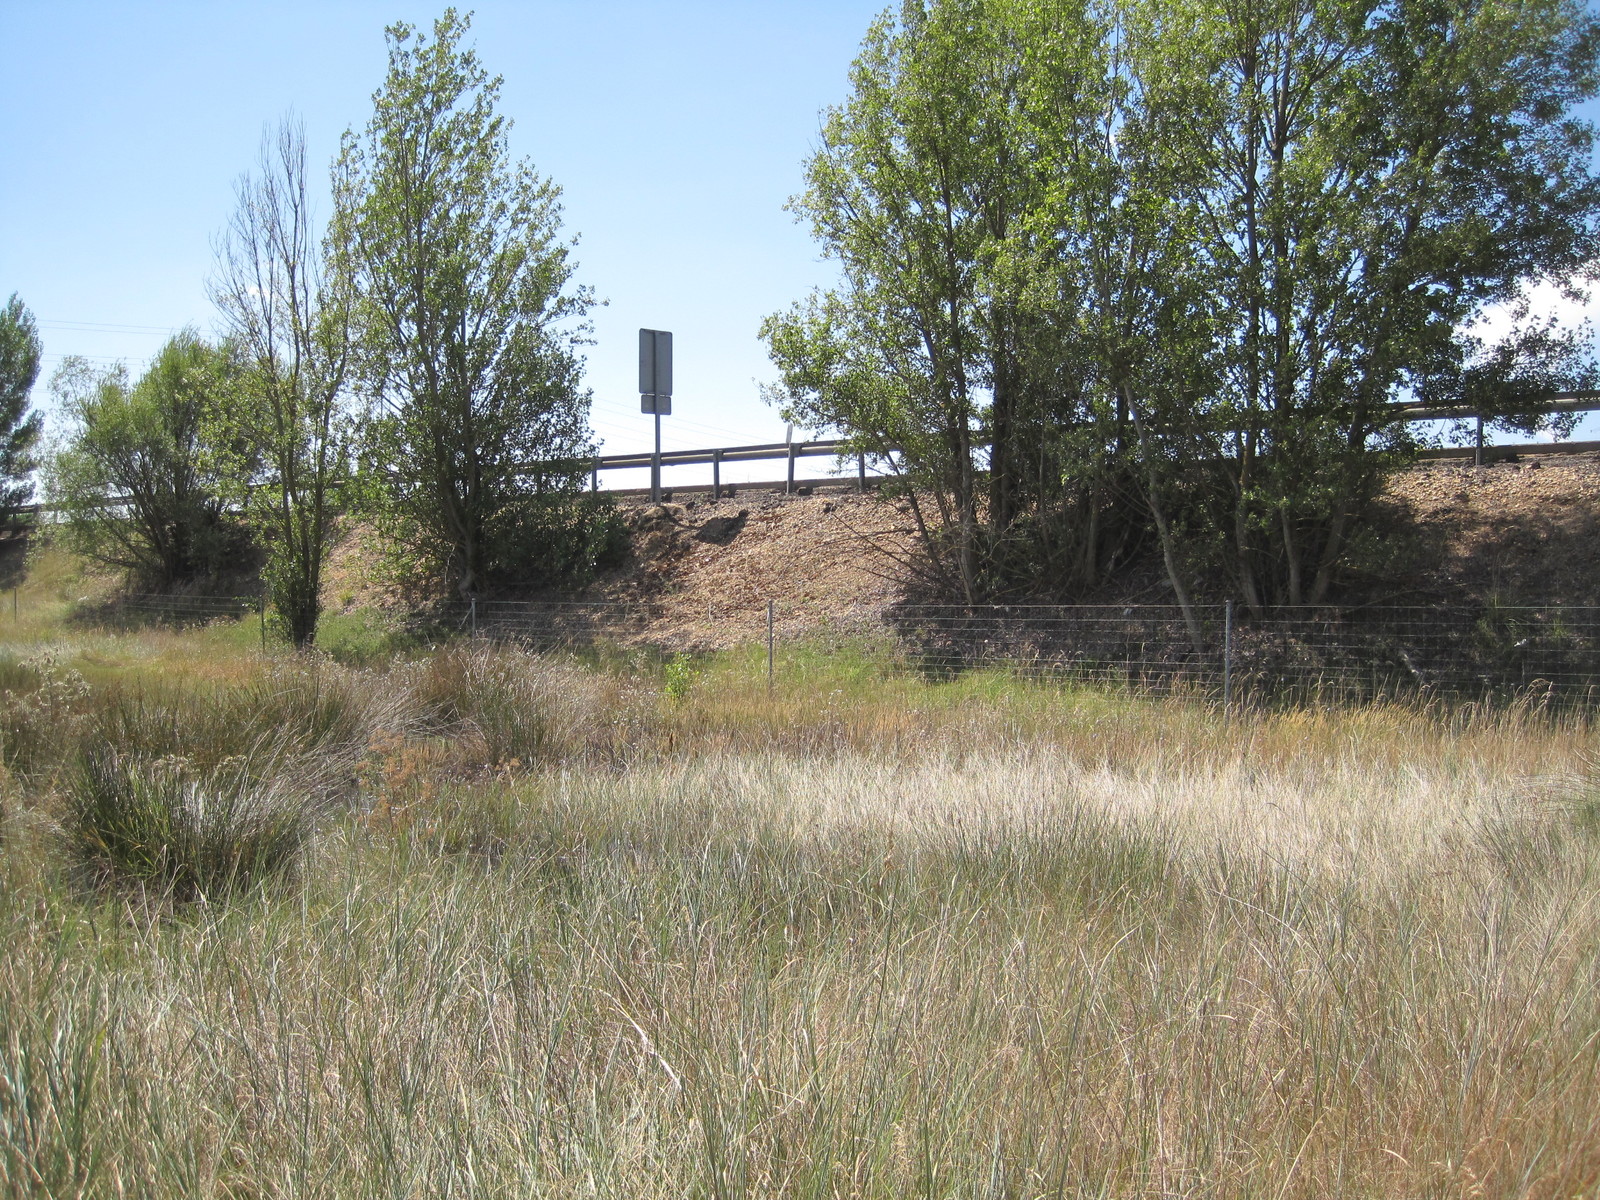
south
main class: Grassland
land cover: Grassland with sparse tree/shrub cover
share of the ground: > 75 %
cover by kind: herbaceous plants 95 %, broadleaved forest trees 5 %
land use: Semi-natural and natural areas not in use
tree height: > 5 m
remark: Temporary flooded
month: July
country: ES
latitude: 41.9976
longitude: -5.6524
